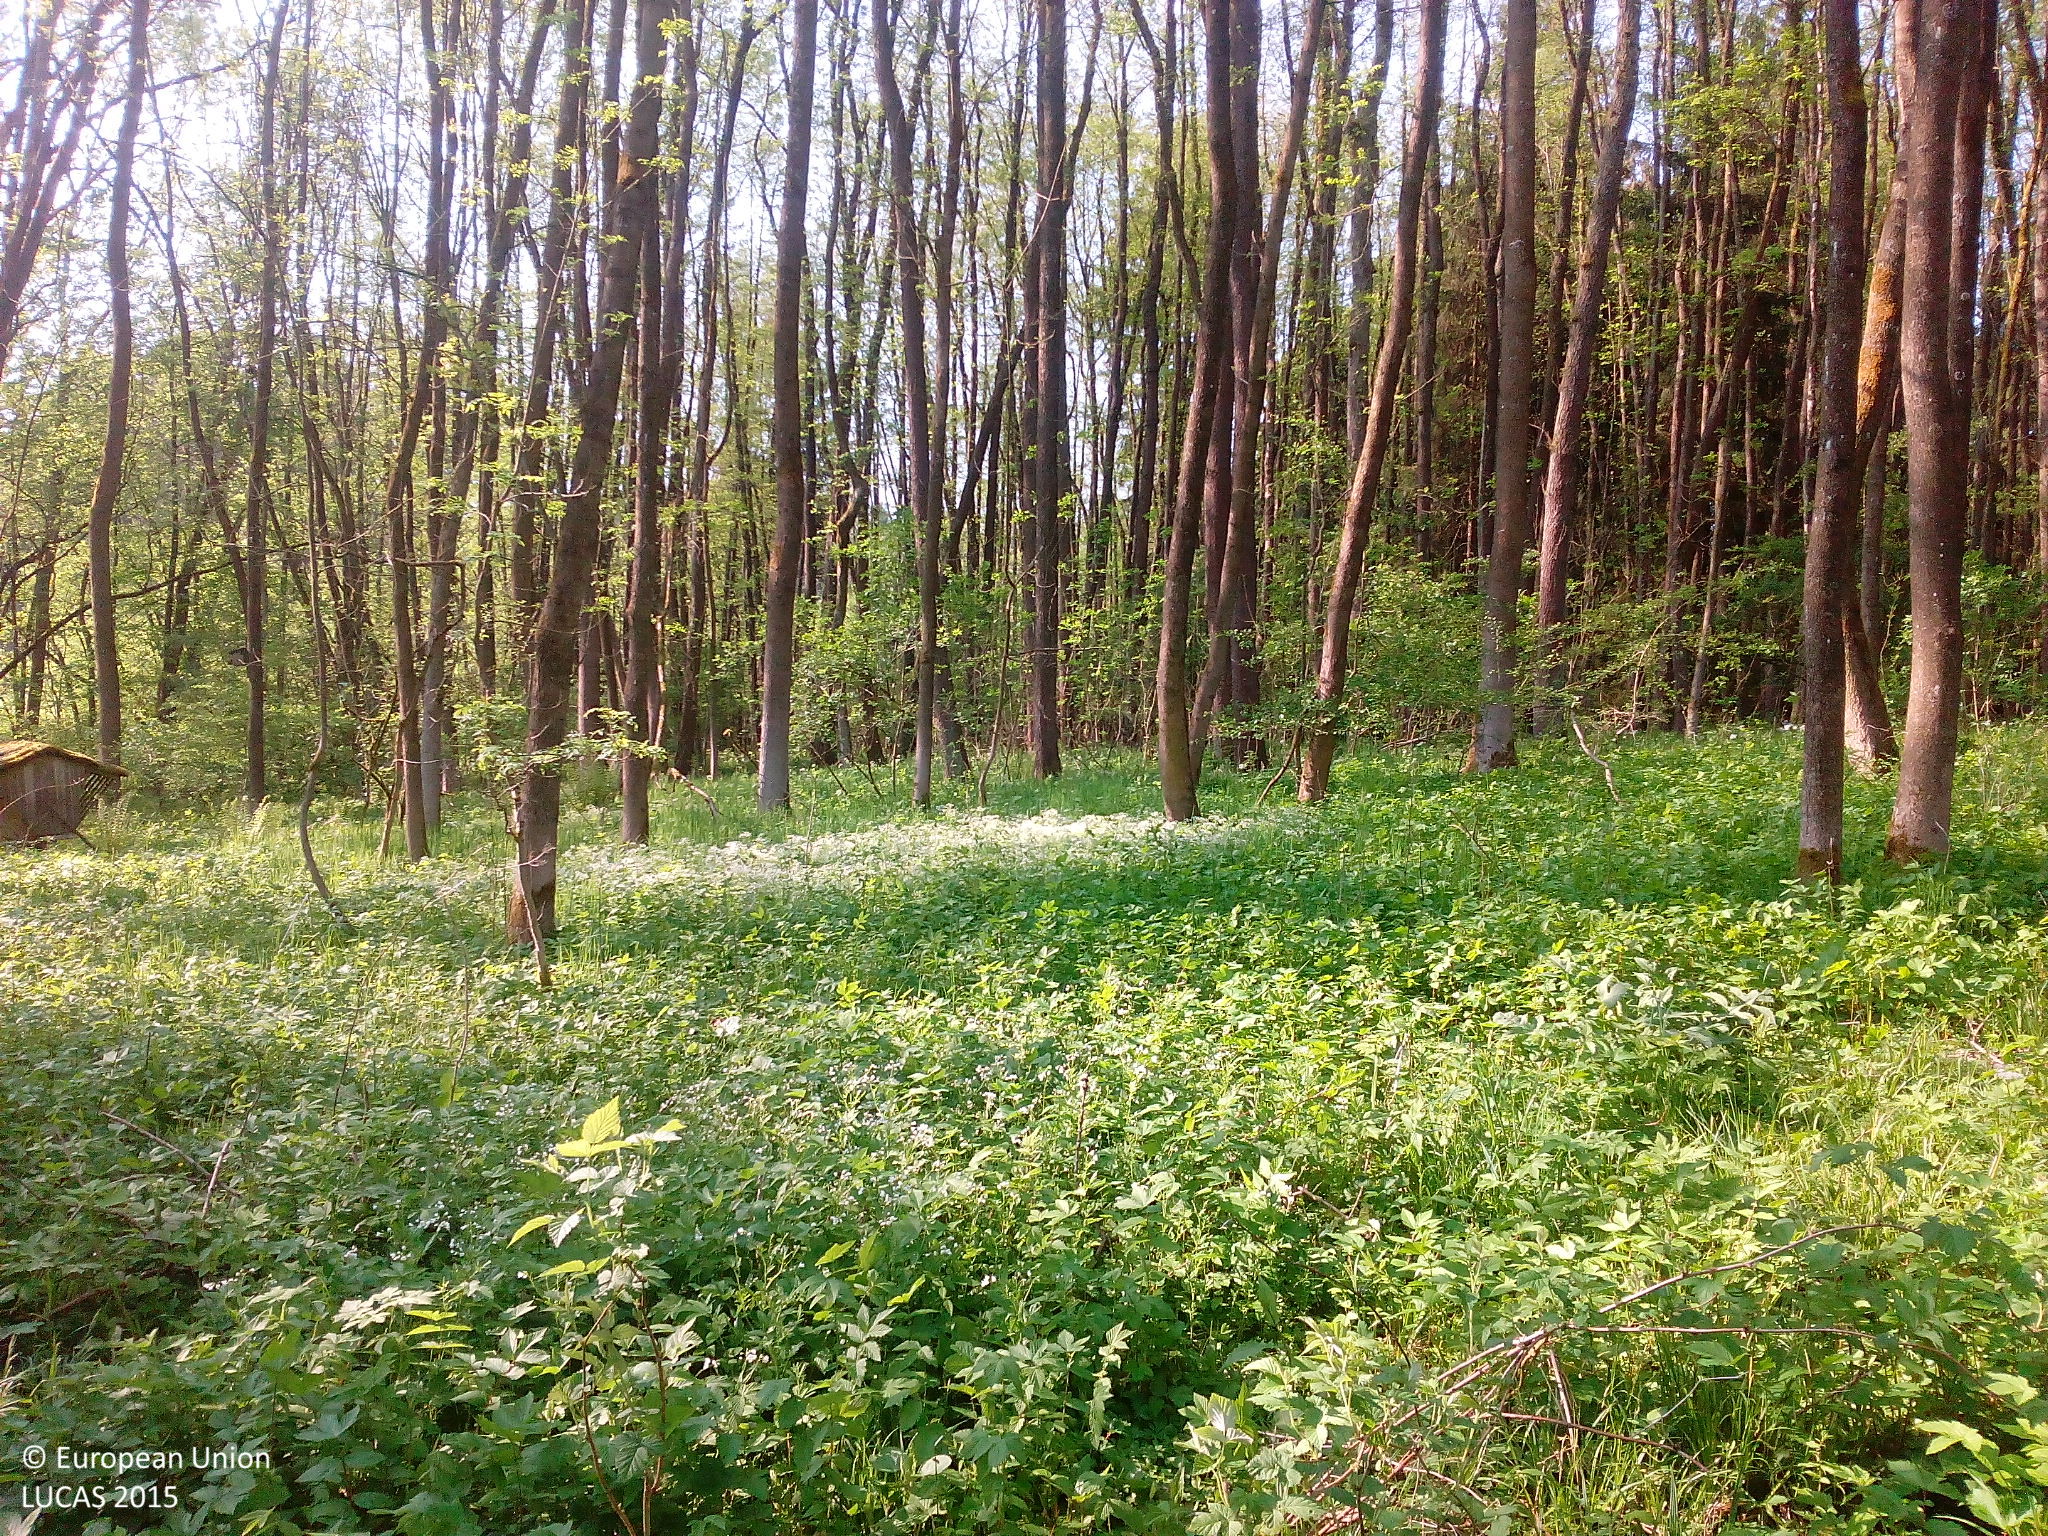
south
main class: Woodland
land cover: Broadleaved woodland
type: mesophytic deciduous forest
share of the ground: > 75 %
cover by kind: broadleaved forest trees 90 %, shrubs 5 %, herbaceous plants 5 %
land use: Forestry
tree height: > 5 m
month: May
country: DE
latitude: 49.8688
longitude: 11.4883
